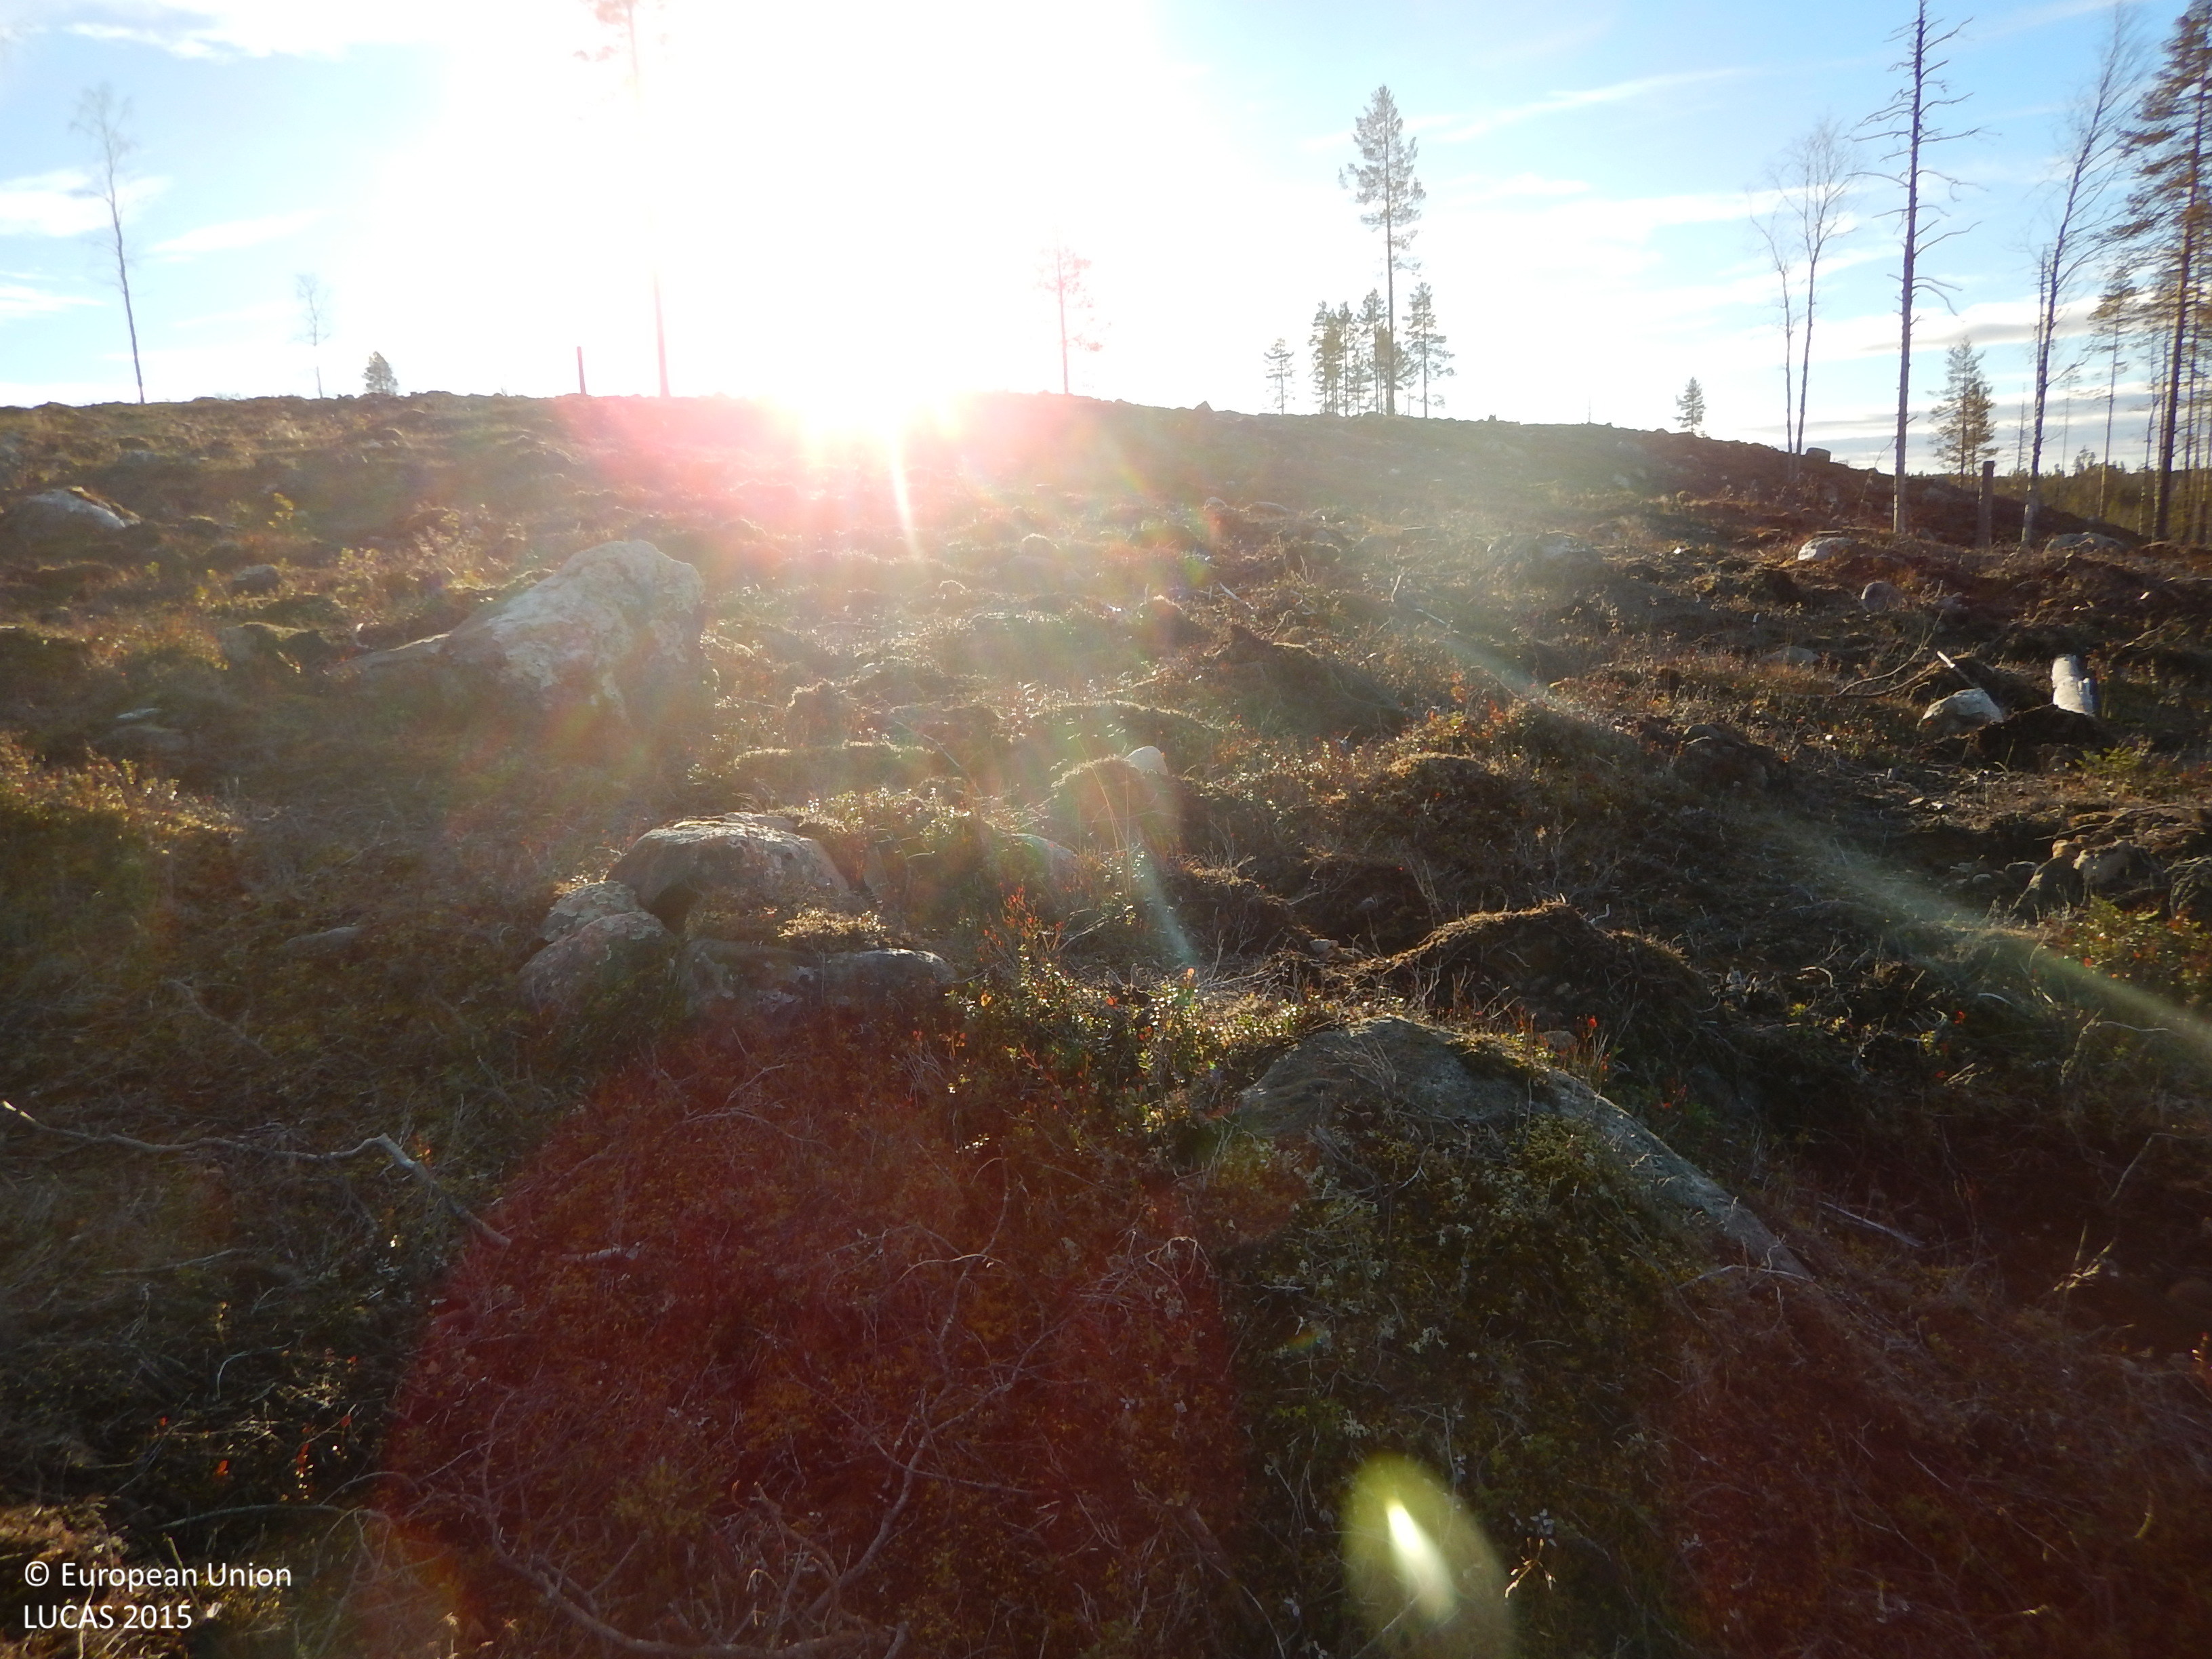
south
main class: Shrubland
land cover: Shrubland with sparse tree cover
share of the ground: 50 - 75 %
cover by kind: shrubs 50 %, herbaceous plants 20 %, lichens and mosses 15 %, coniferous forest trees 5 %, consolidated bare surface 5 %, unconsolidated bare surface 5 %
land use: Forestry
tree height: < 5 m
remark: Clear cut
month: November
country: SE
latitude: 65.3389
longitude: 20.6015
